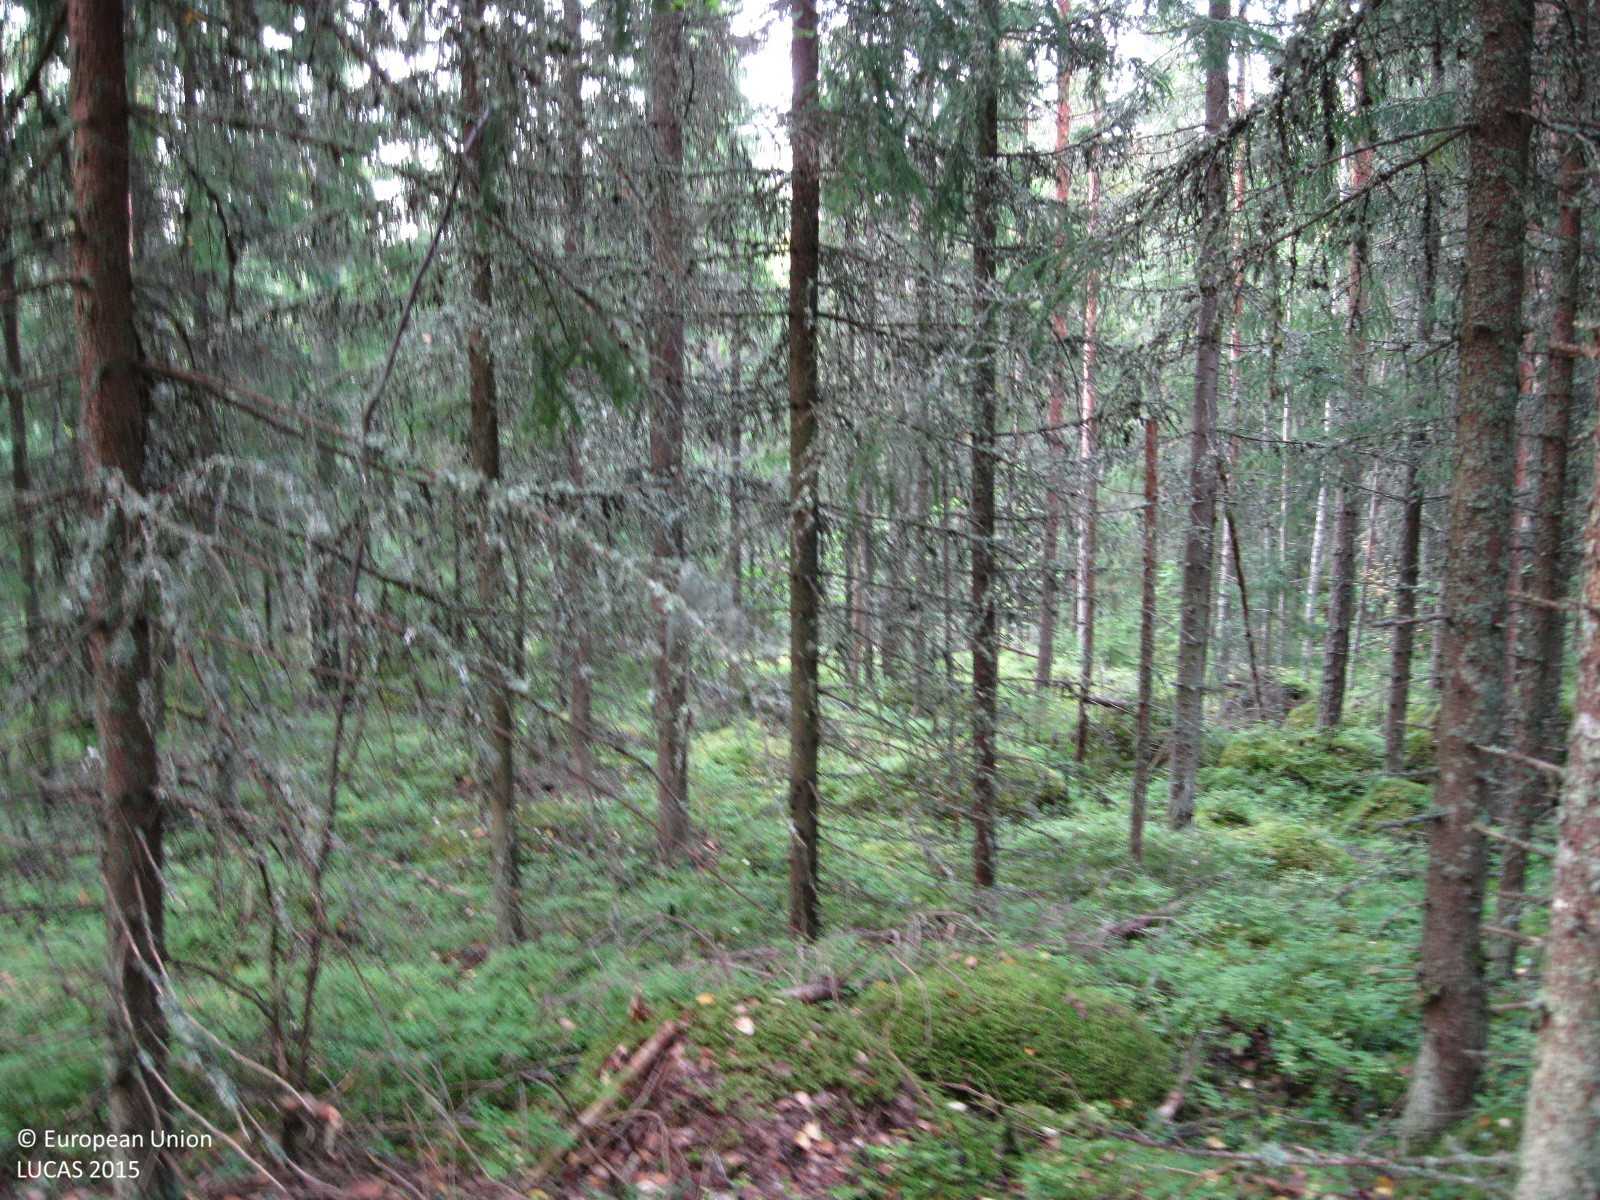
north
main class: Woodland
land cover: Other mixed woodland
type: boreal forest
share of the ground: > 75 %
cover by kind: coniferous forest trees 55 %, broadleaved forest trees 20 %, lichens and mosses 15 %, shrubs 10 %
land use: Forestry
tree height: > 5 m
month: September
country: FI
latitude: 60.7898
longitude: 24.9757
